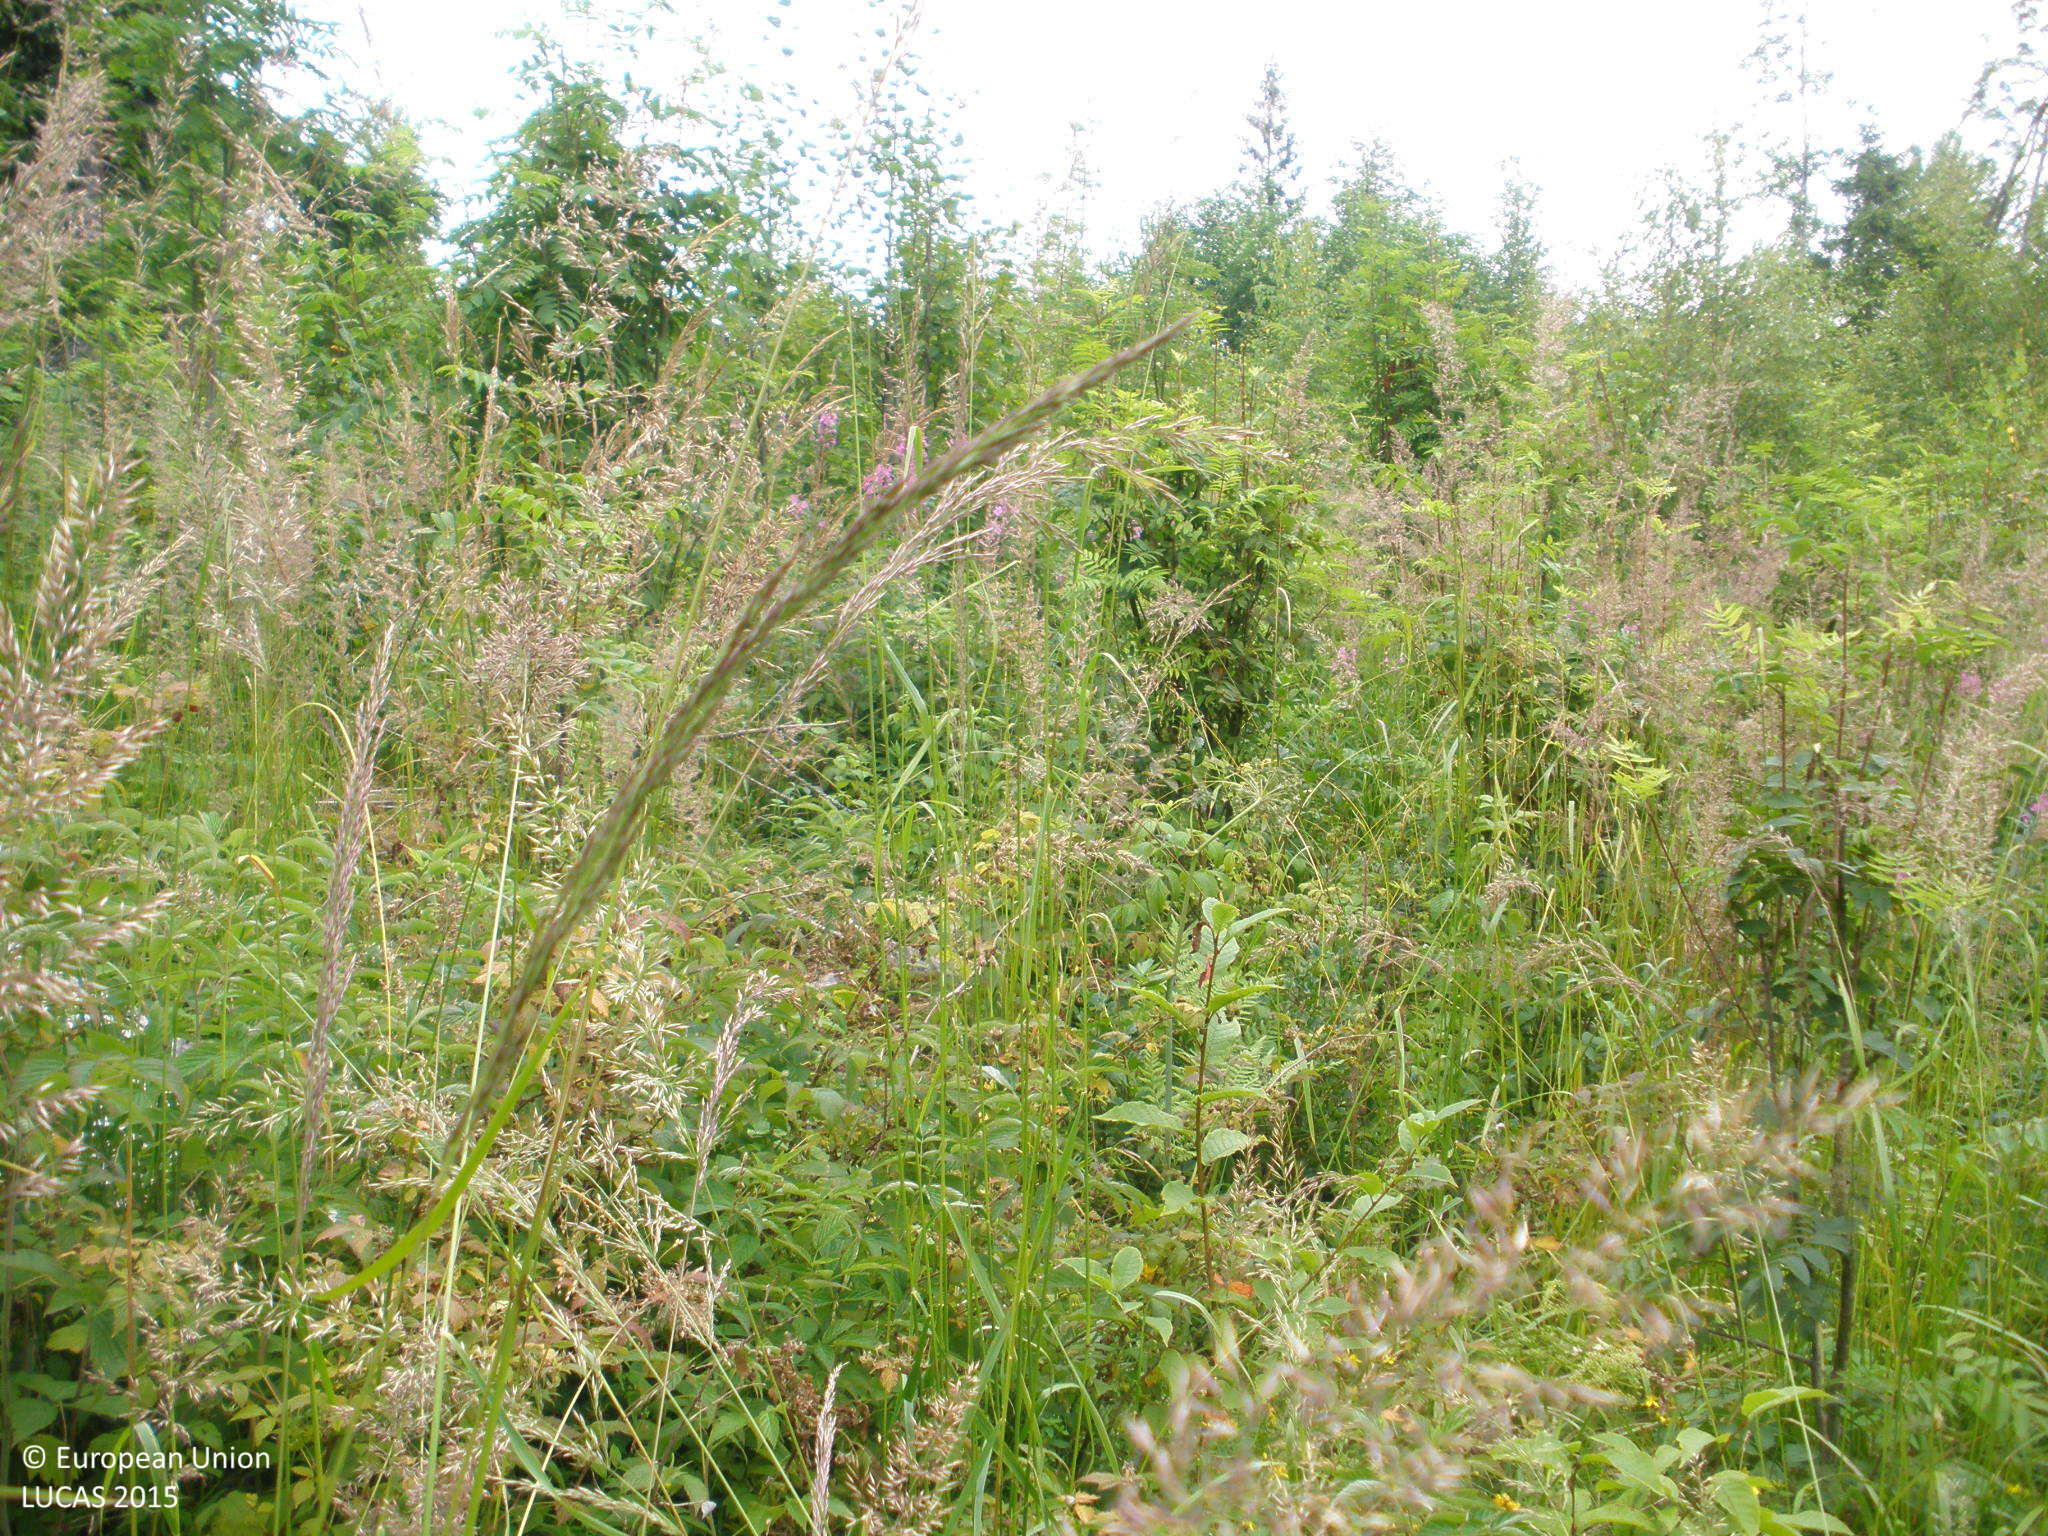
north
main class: Woodland
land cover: Other mixed woodland
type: boreal forest
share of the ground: 25 - 50 %
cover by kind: herbaceous plants 40 %, coniferous forest trees 20 %, broadleaved forest trees 20 %, shrubs 20 %
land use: Forestry
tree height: < 5 m
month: July
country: FI
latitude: 61.0976
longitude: 25.1966
